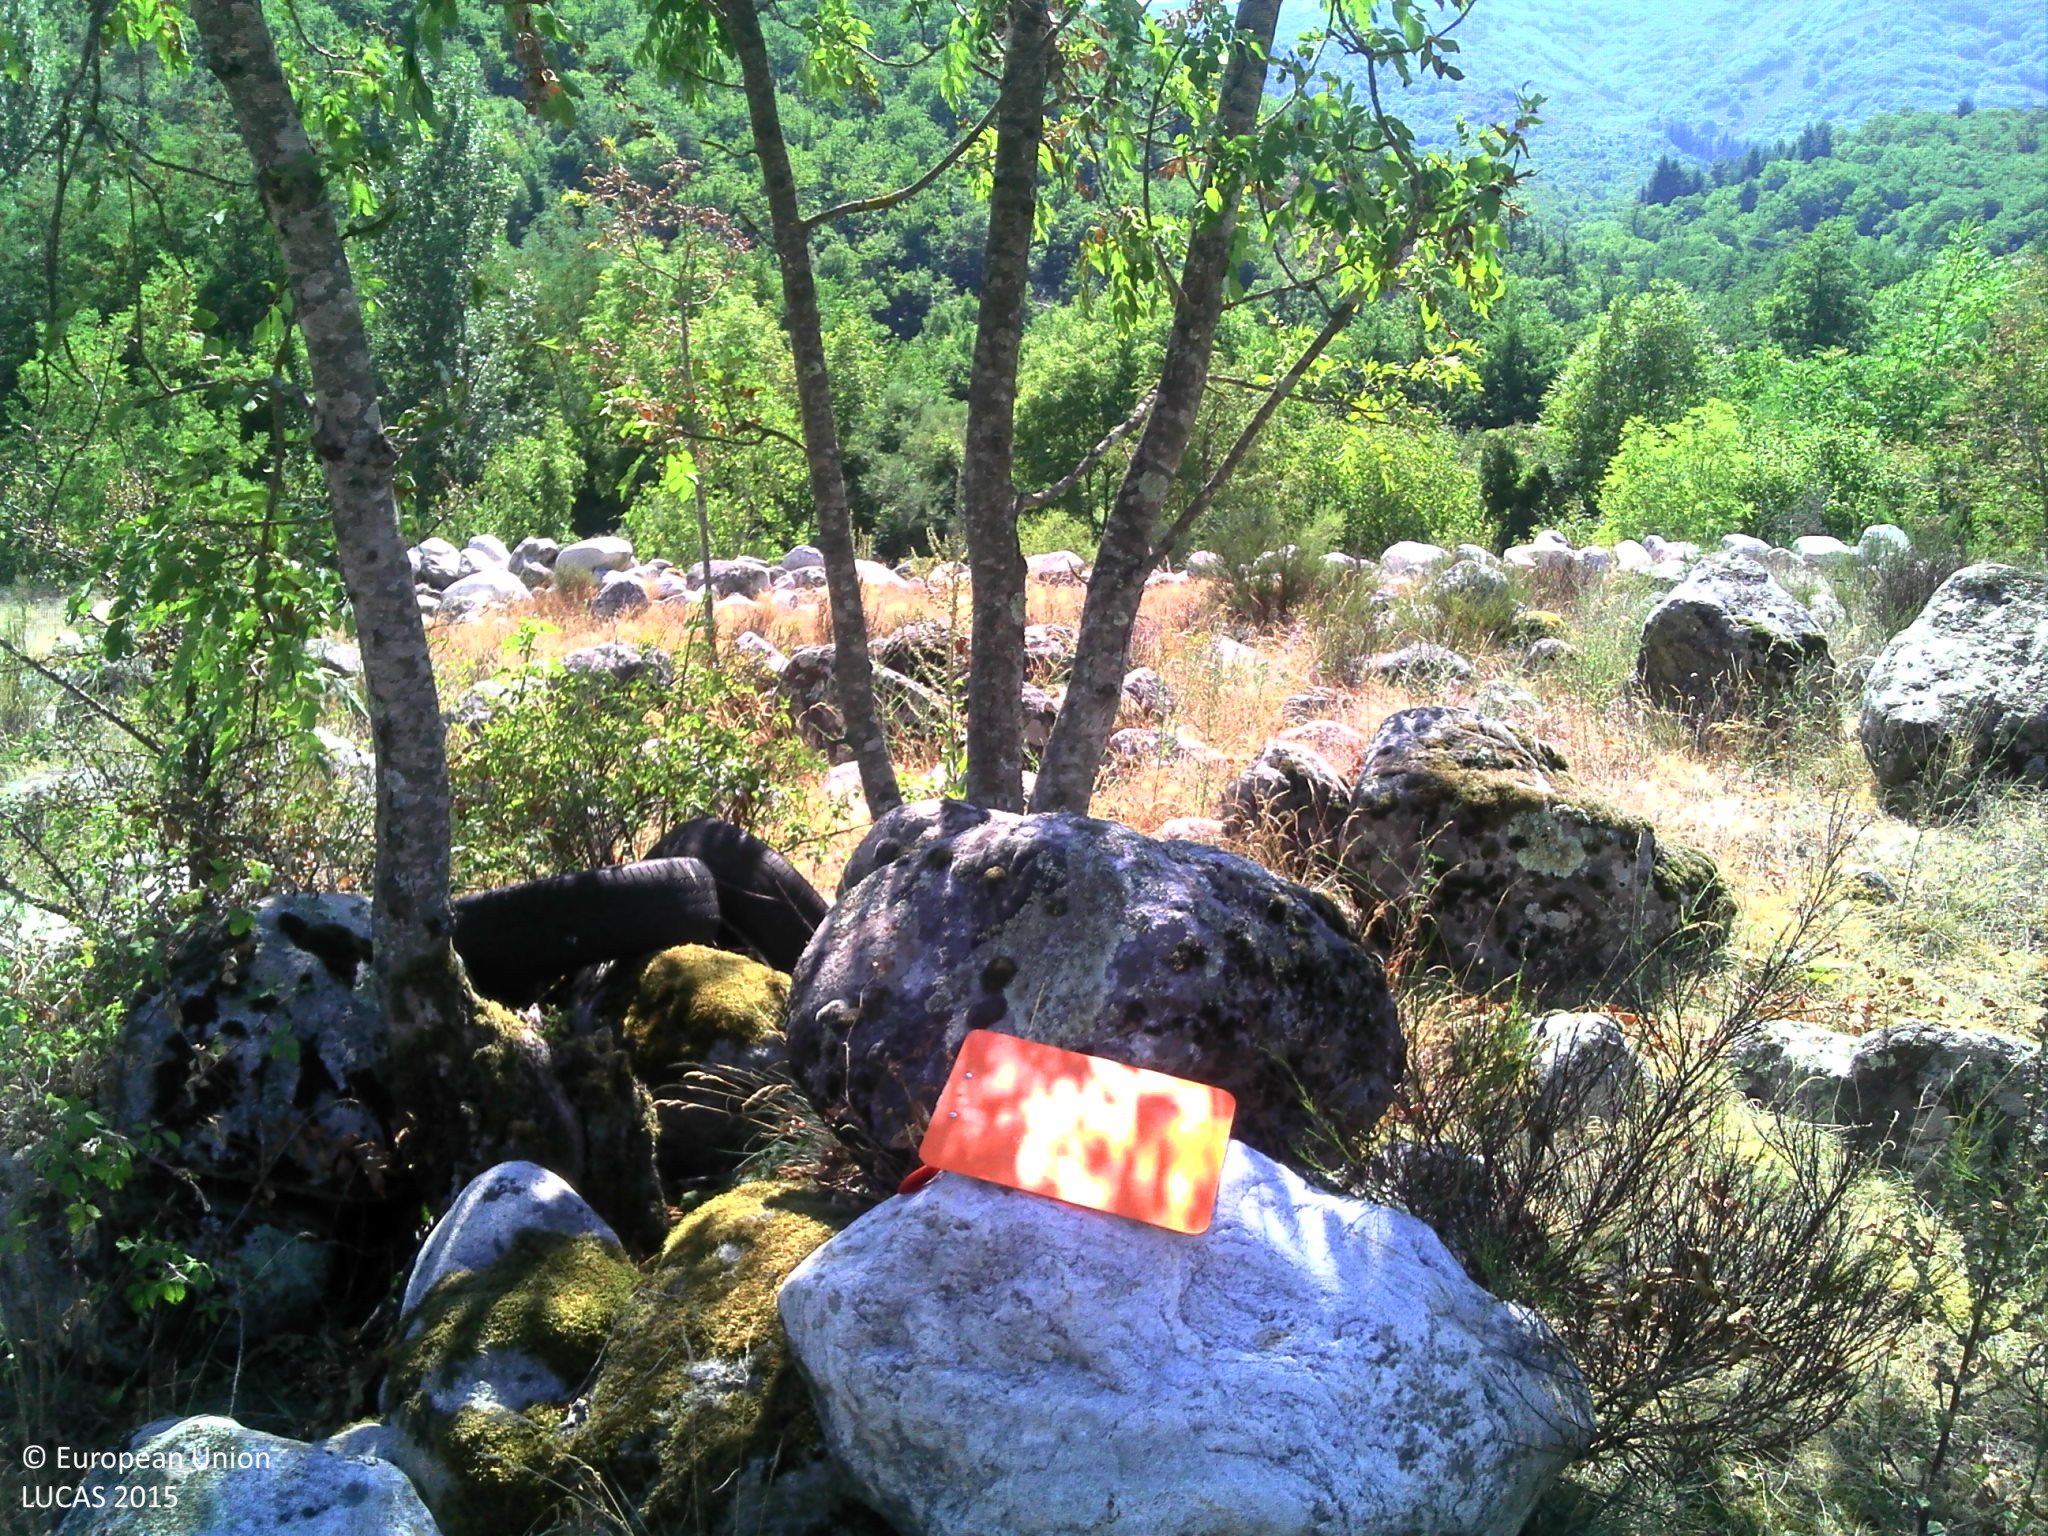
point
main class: Grassland
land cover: Grassland with sparse tree/shrub cover
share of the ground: > 75 %
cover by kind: herbaceous plants 85 %, broadleaved forest trees 5 %, shrubs 5 %
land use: Semi-natural and natural areas not in use
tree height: < 5 m
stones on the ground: 10 - 25 %
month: August
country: FR
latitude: 44.6233
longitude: 4.2210
